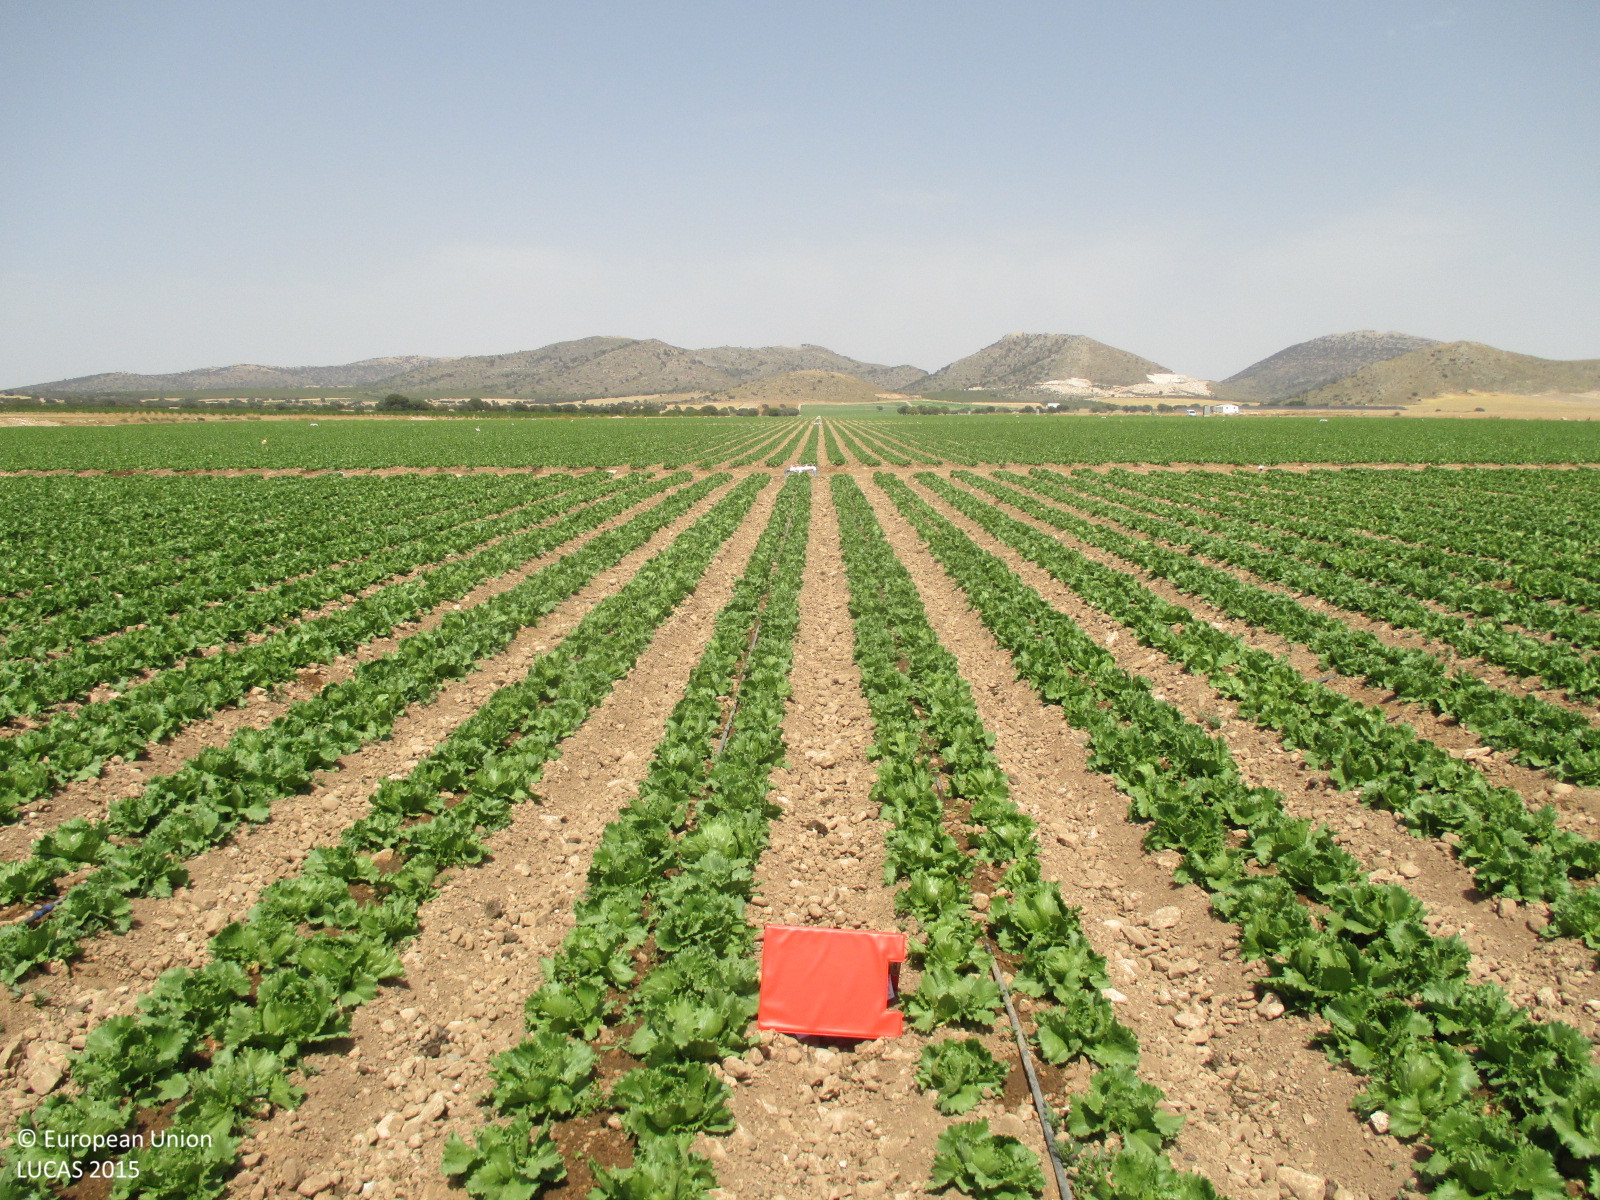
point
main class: Cropland
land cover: Other fresh vegetables
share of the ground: < 10 %
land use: Agriculture (excluding fallow land and kitchen gardens)
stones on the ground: 10 - 25 %
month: July
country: ES
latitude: 37.8977
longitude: -2.3055
